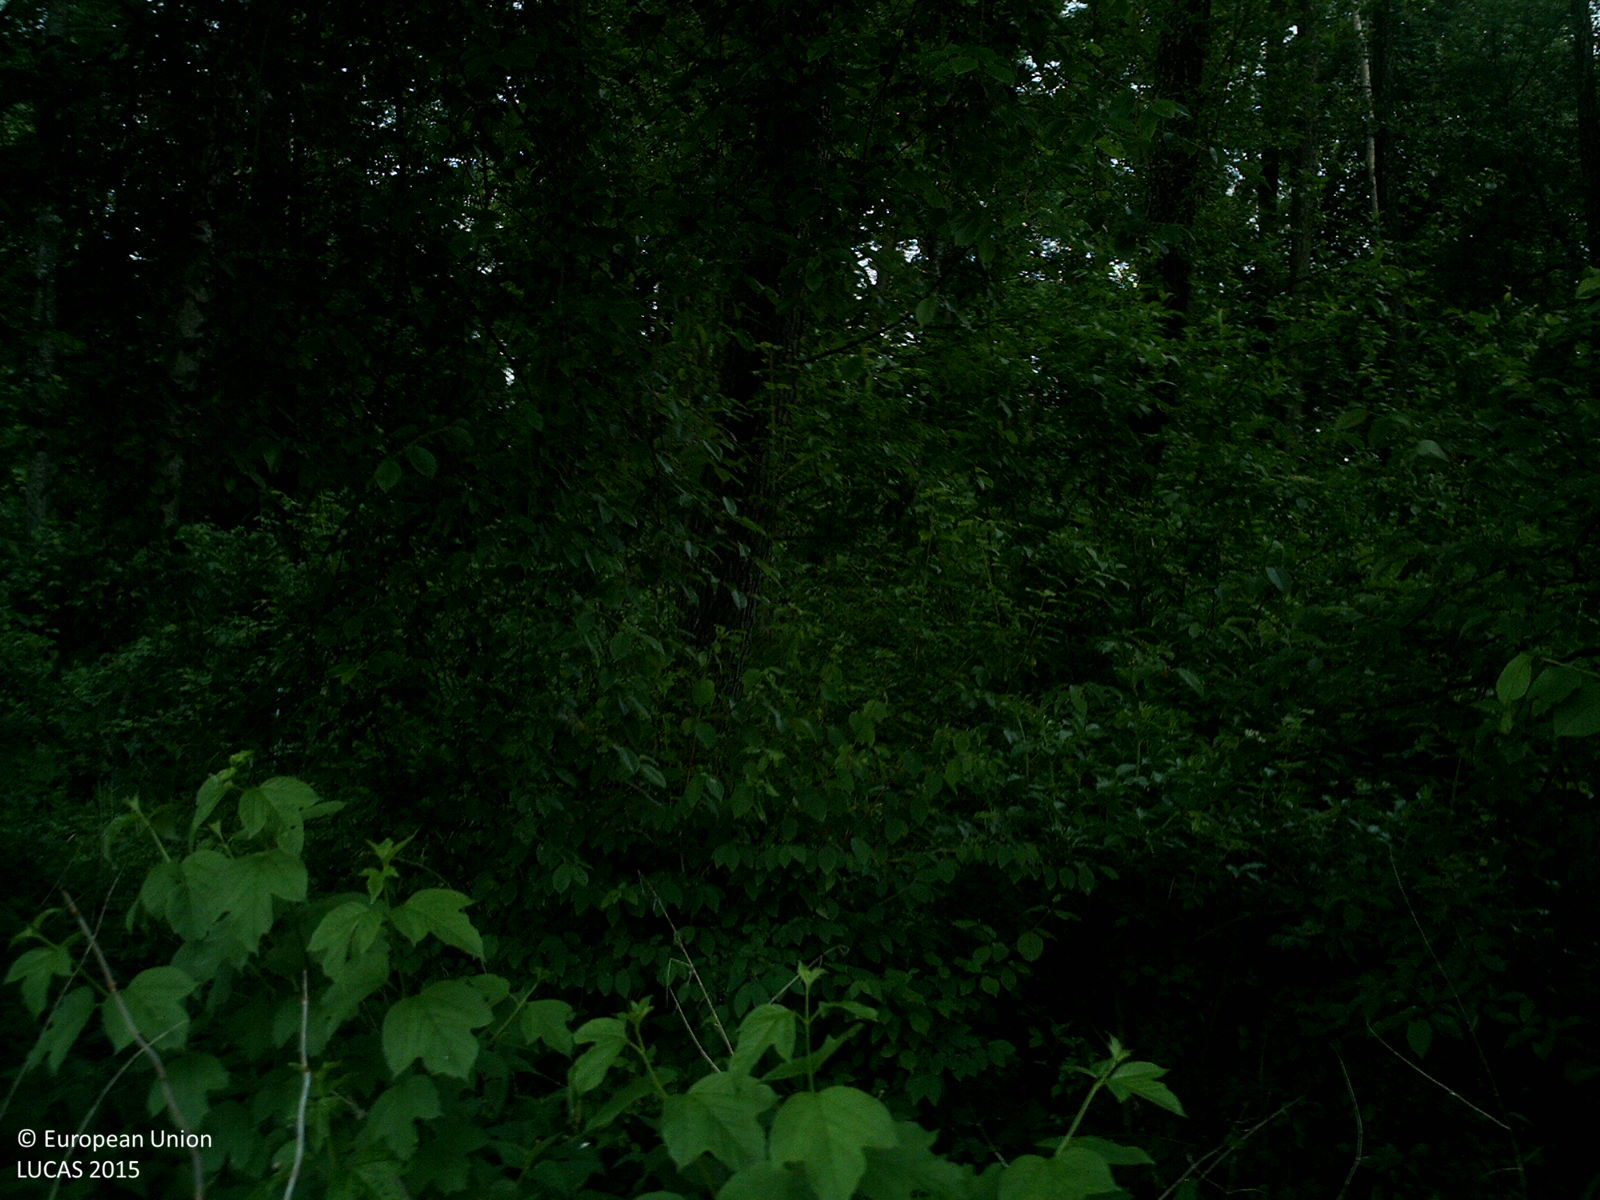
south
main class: Woodland
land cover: Broadleaved woodland
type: acidophilous oak and oak-birch forest
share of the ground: > 75 %
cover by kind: broadleaved forest trees 100 %
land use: Forestry
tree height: > 5 m
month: May
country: AT
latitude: 48.0755
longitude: 14.0934
